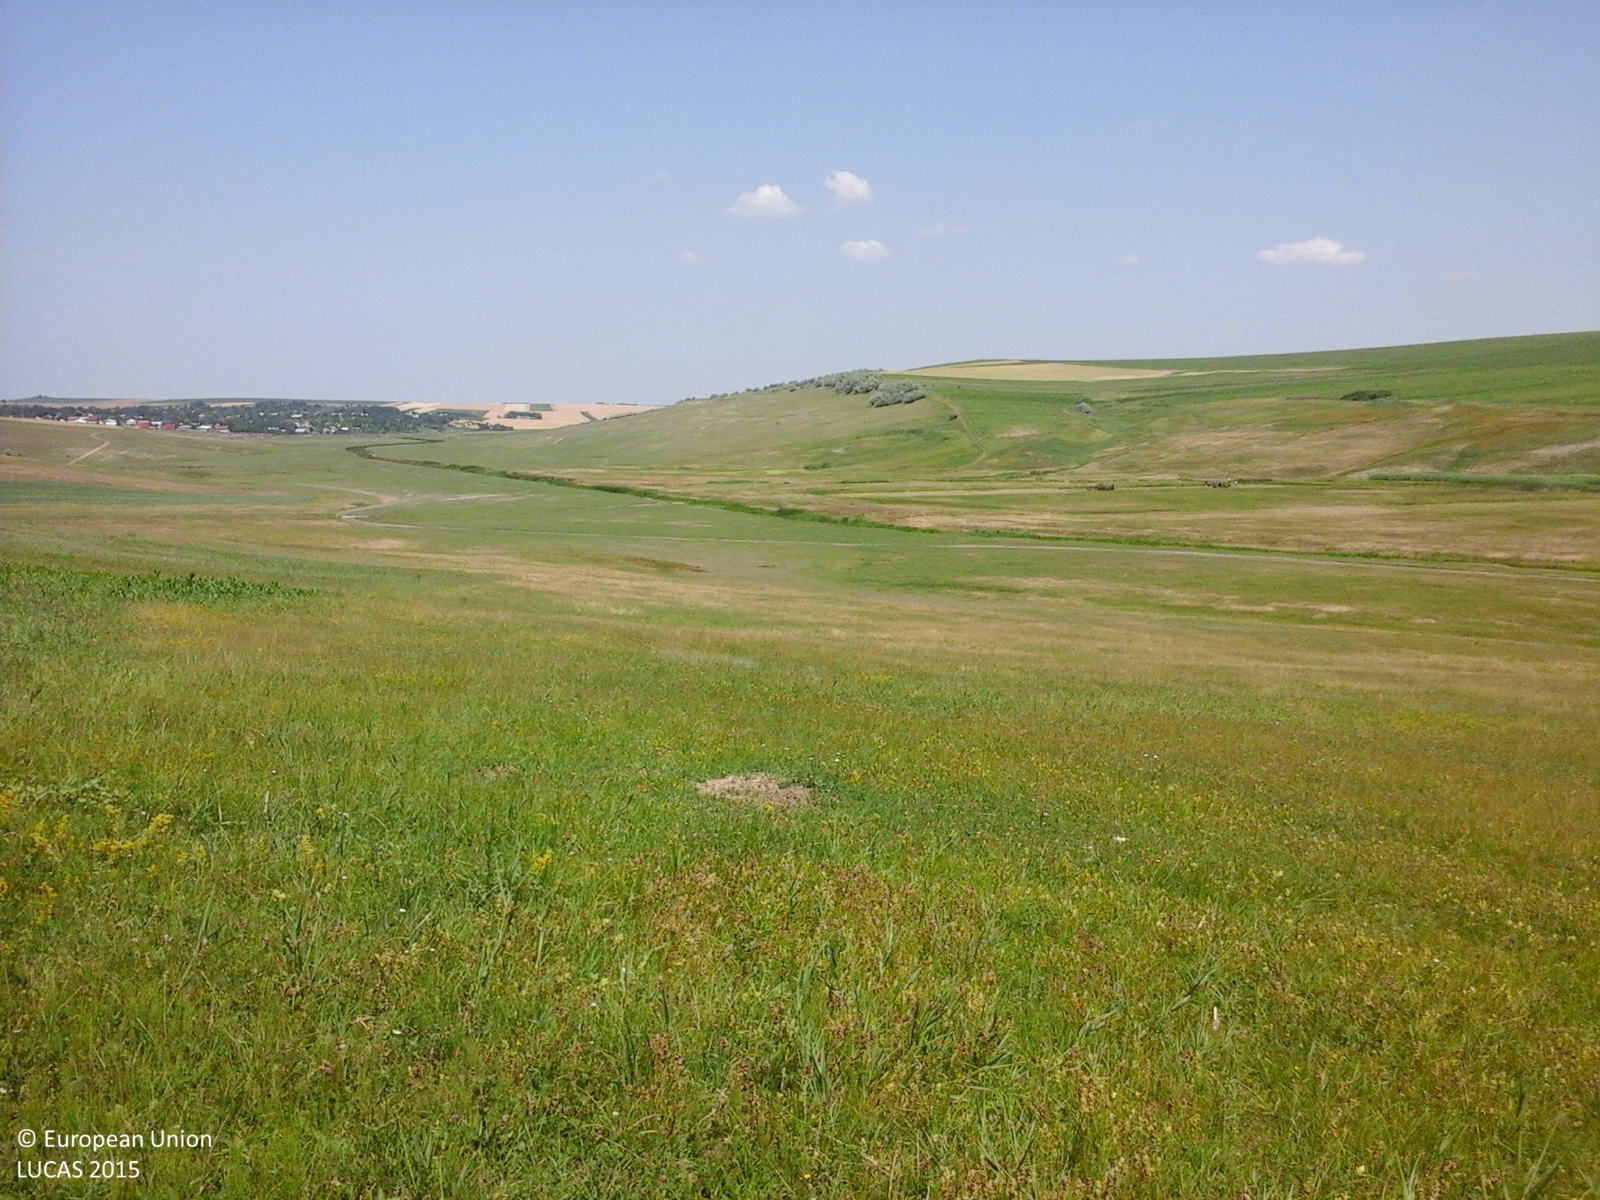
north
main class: Grassland
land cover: Grassland without tree/shrub cover
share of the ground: > 75 %
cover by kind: herbaceous plants 100 %
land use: Agriculture (excluding fallow land and kitchen gardens)
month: June
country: RO
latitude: 47.1720
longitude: 27.1920
